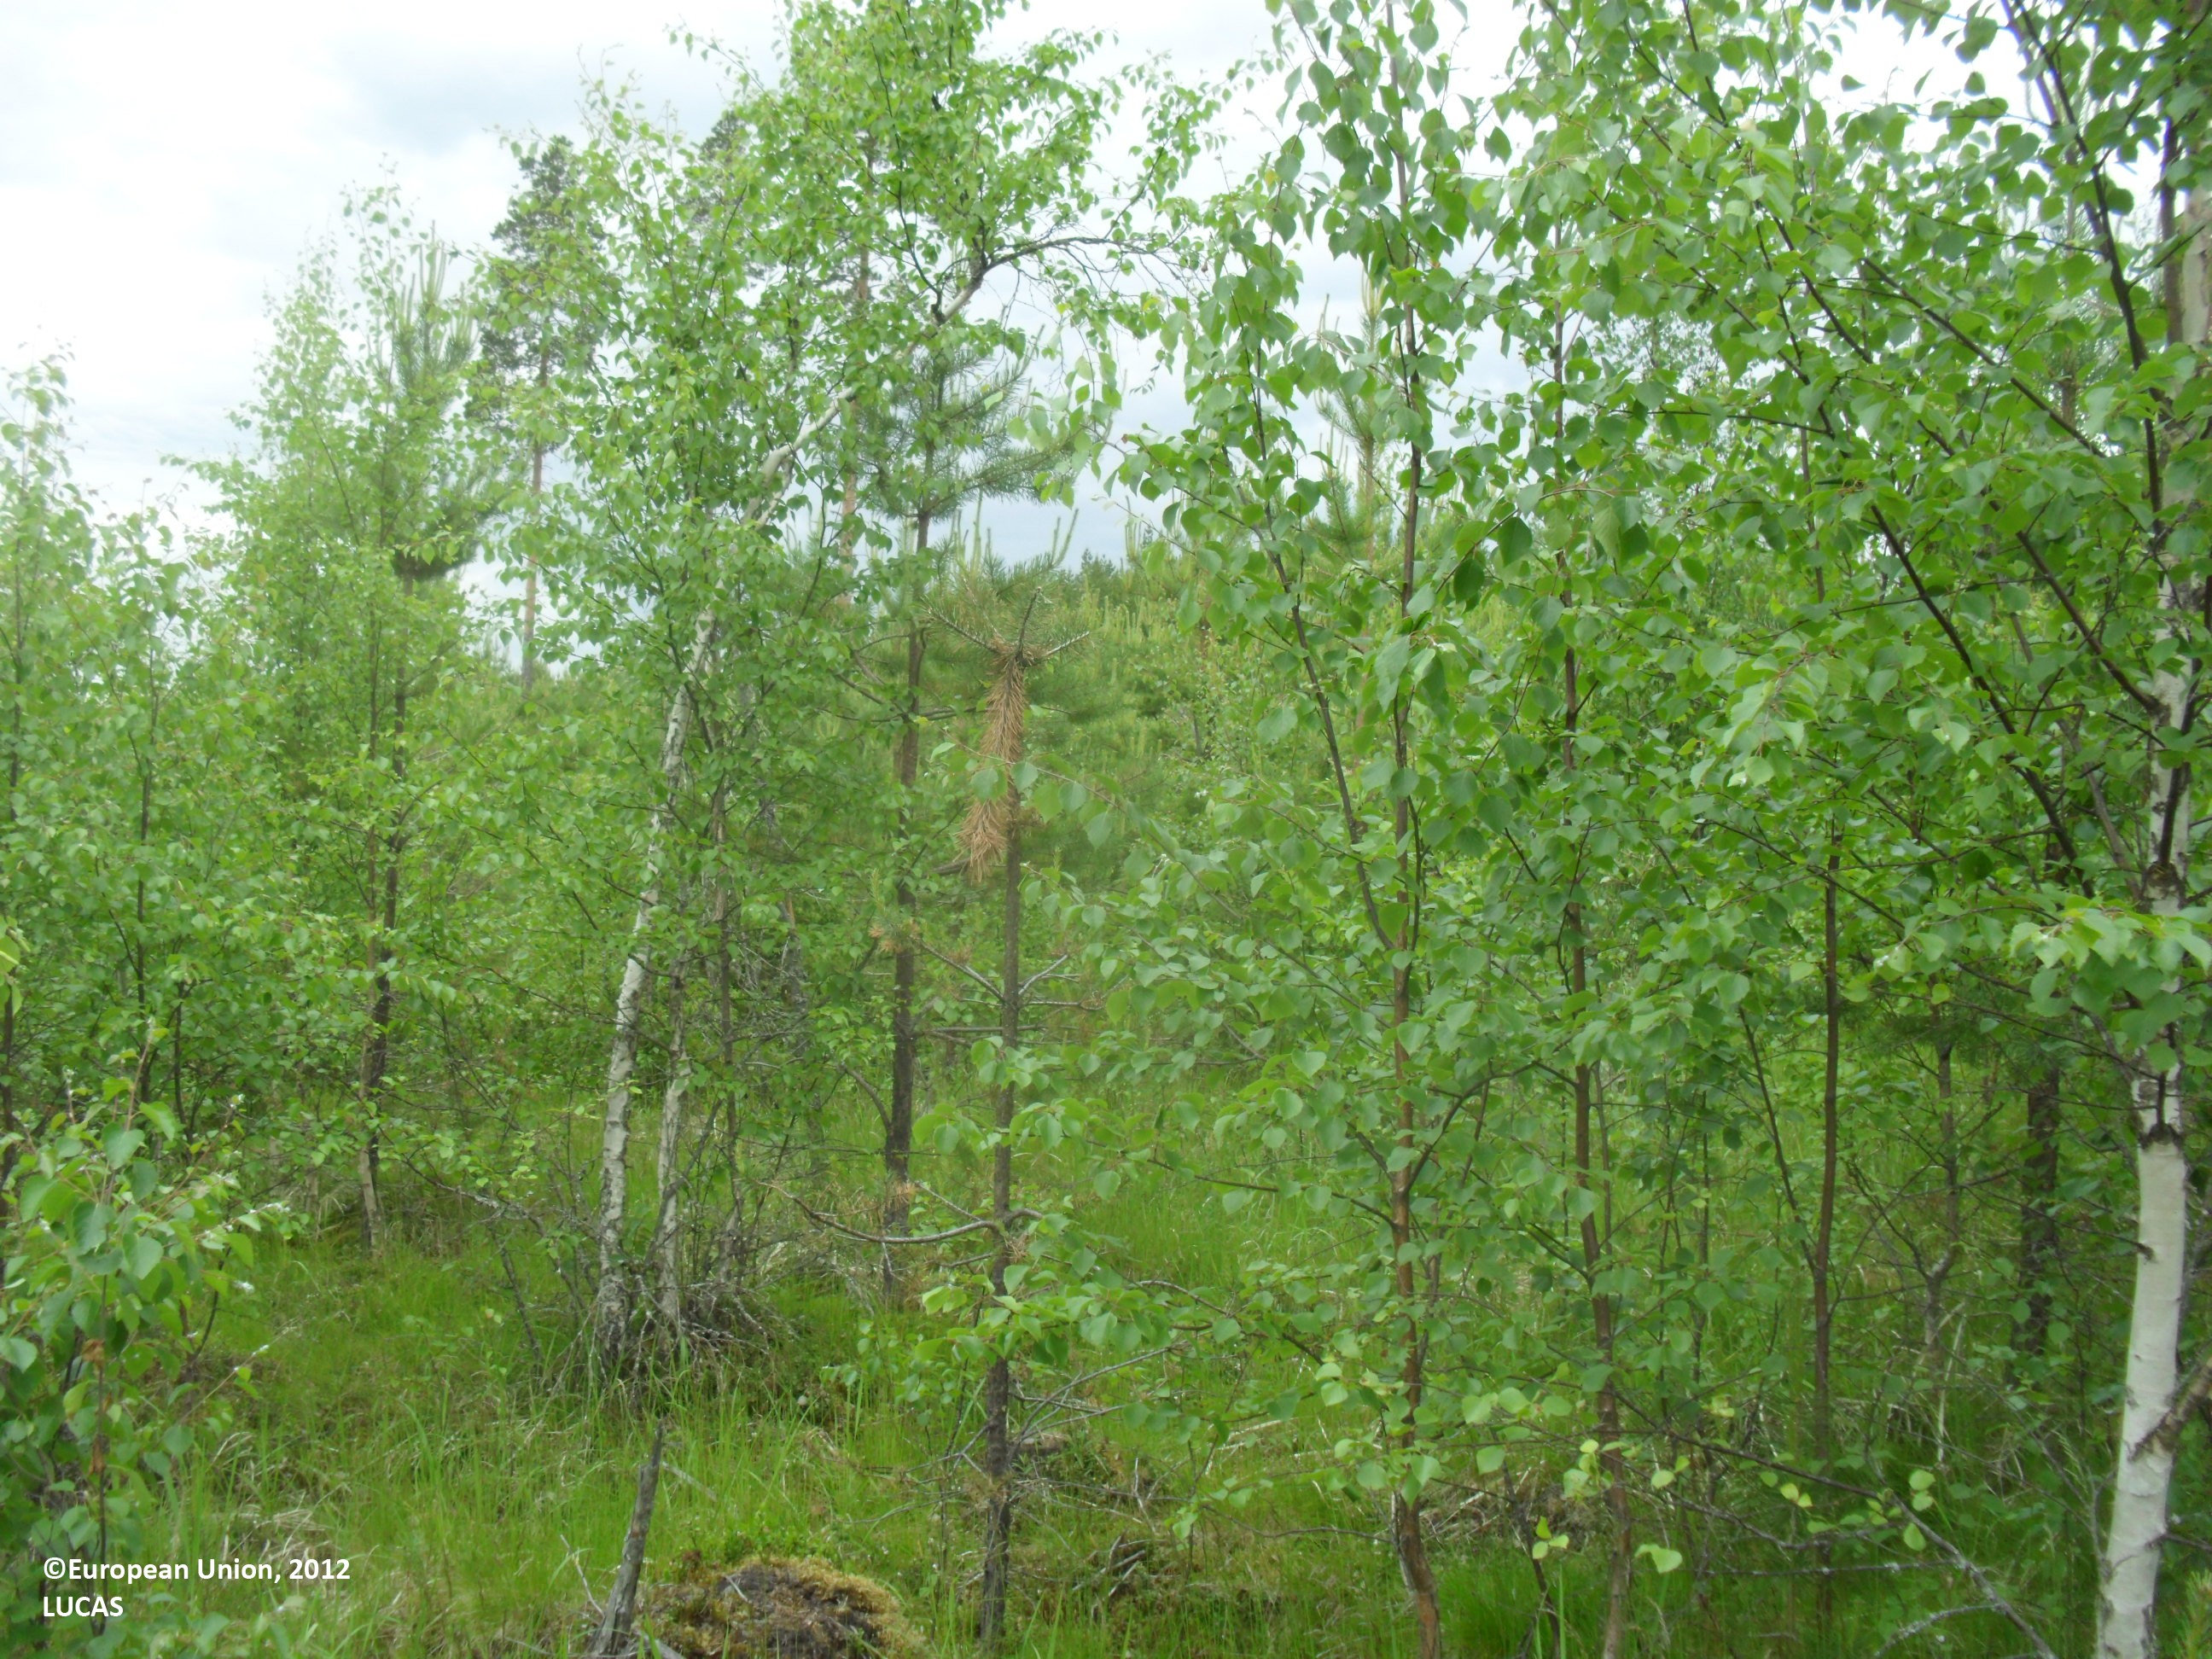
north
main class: Woodland
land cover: Pine dominated mixed woodland
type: boreal forest
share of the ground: 25 - 50 %
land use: Forestry
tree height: < 5 m
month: June
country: FI
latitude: 63.3999
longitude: 23.6576
